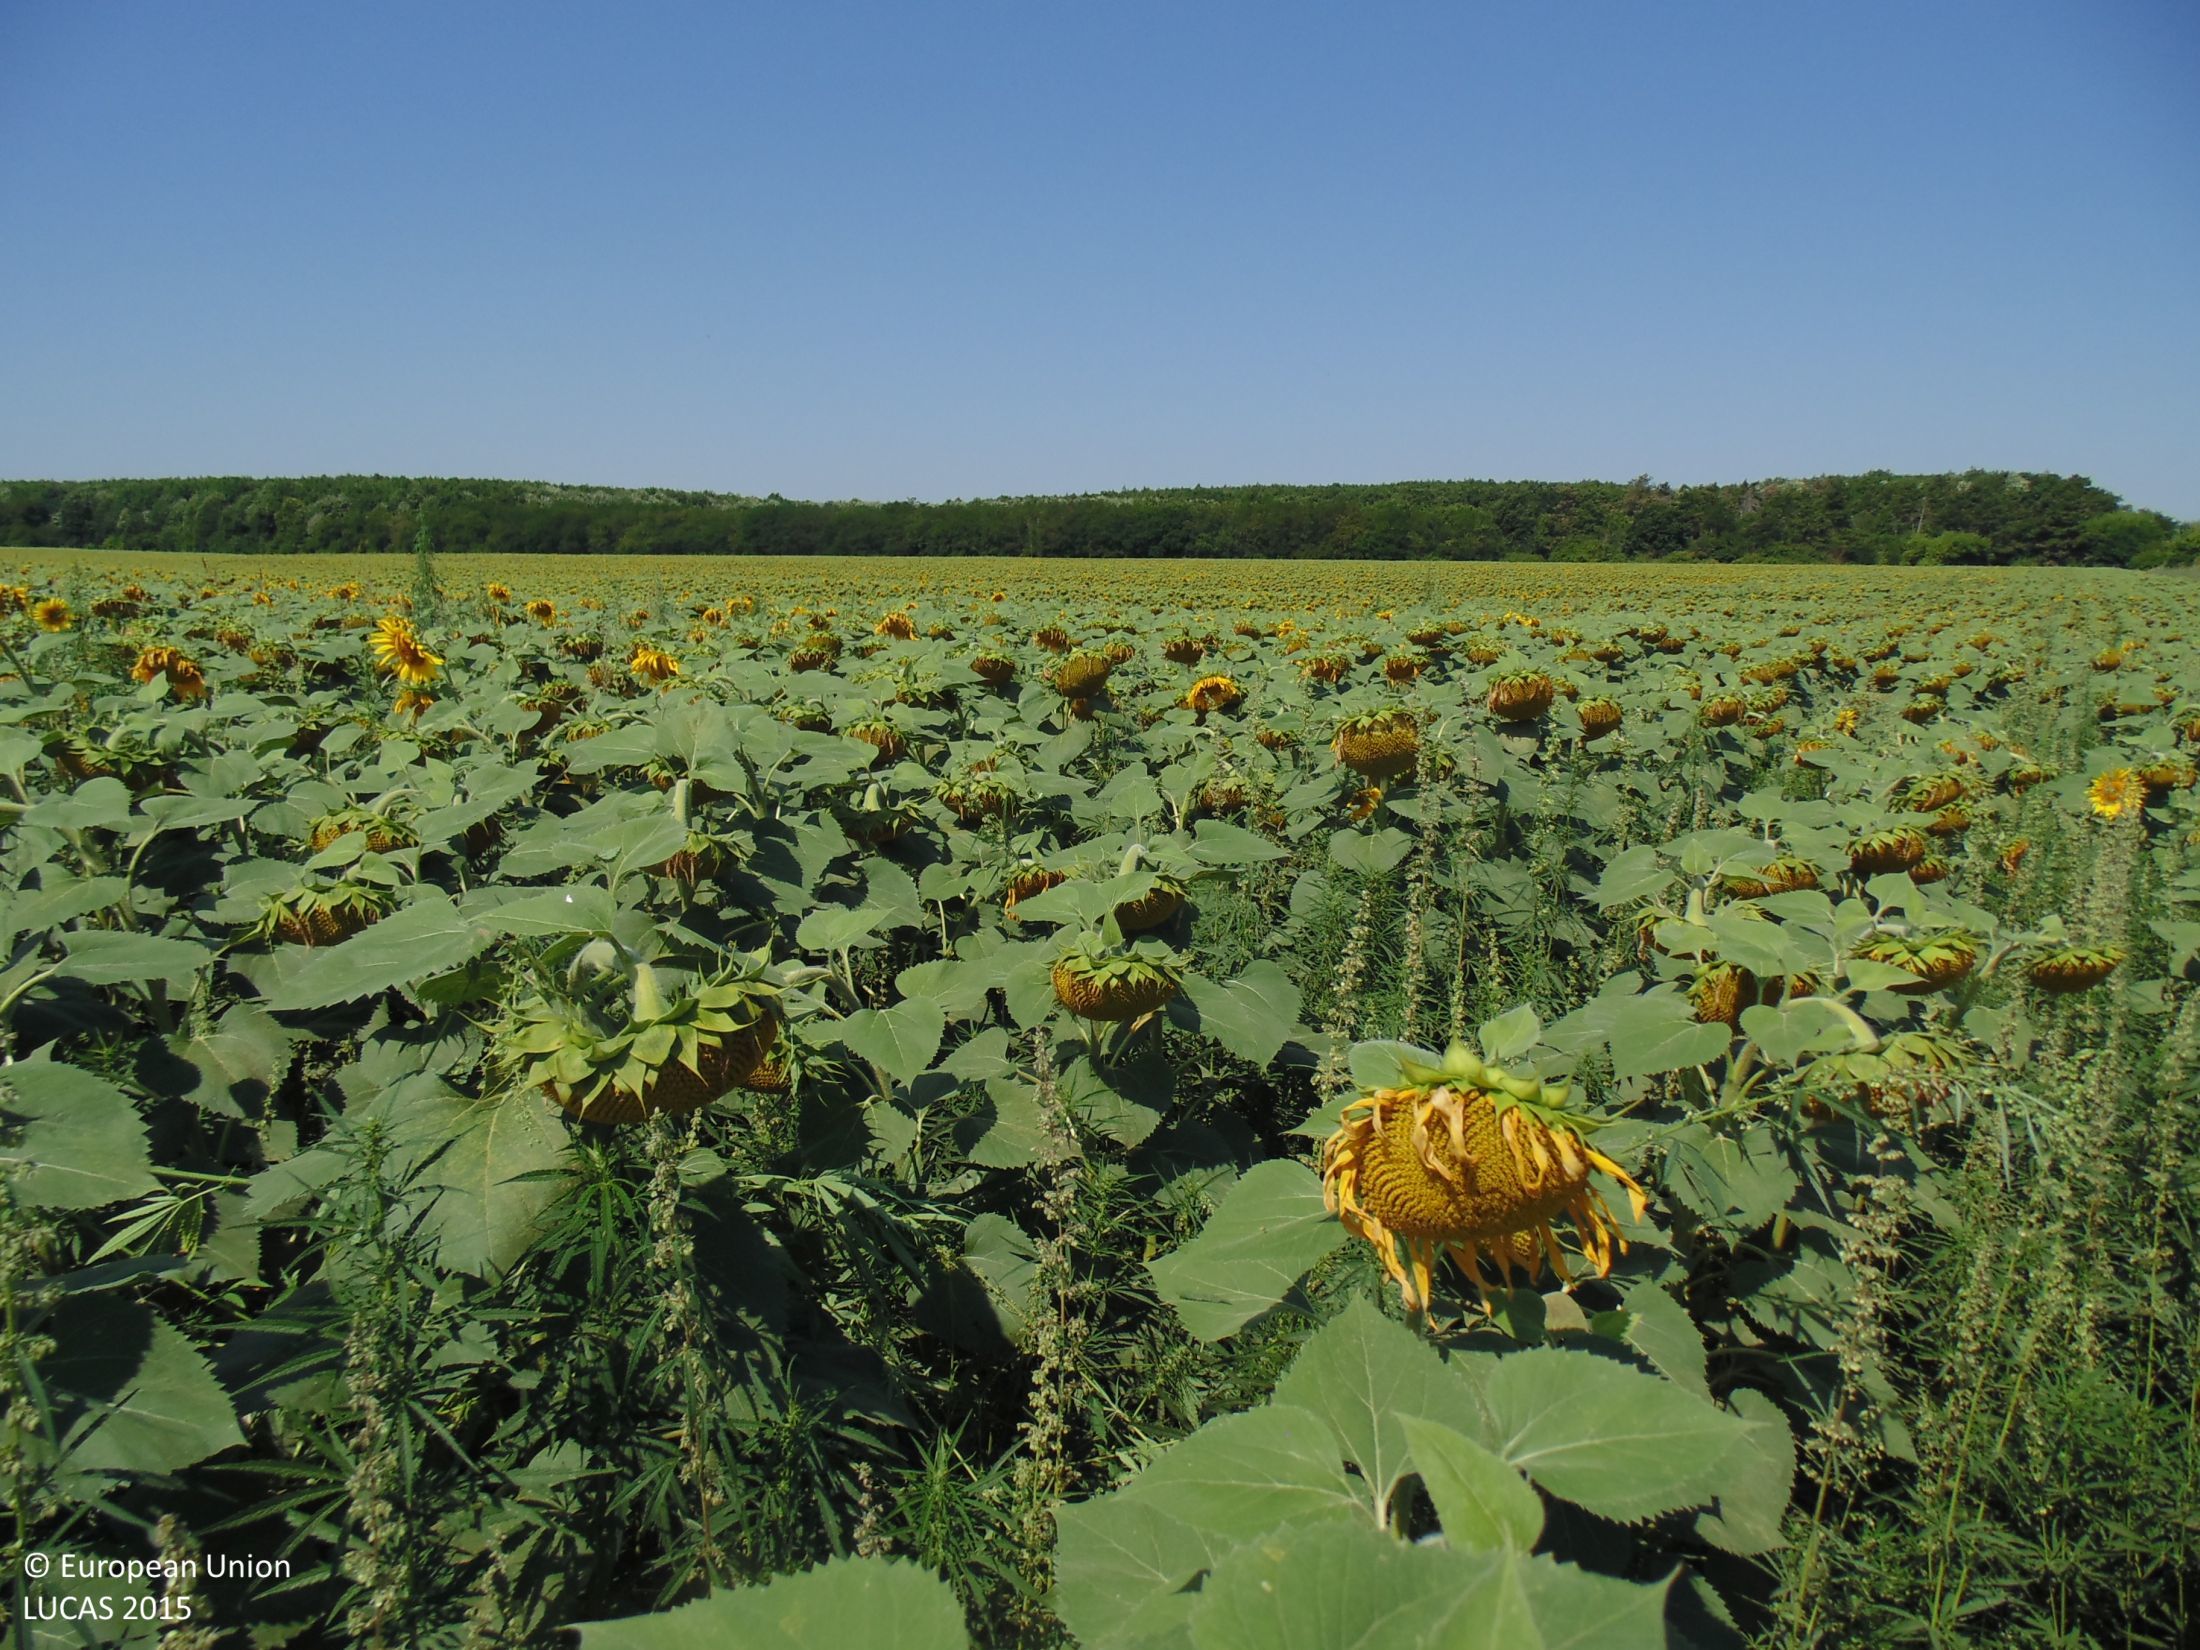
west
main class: Cropland
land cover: Sunflower
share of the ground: > 75 %
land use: Agriculture (excluding fallow land and kitchen gardens)
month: July
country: BG
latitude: 43.6077
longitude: 27.6939
